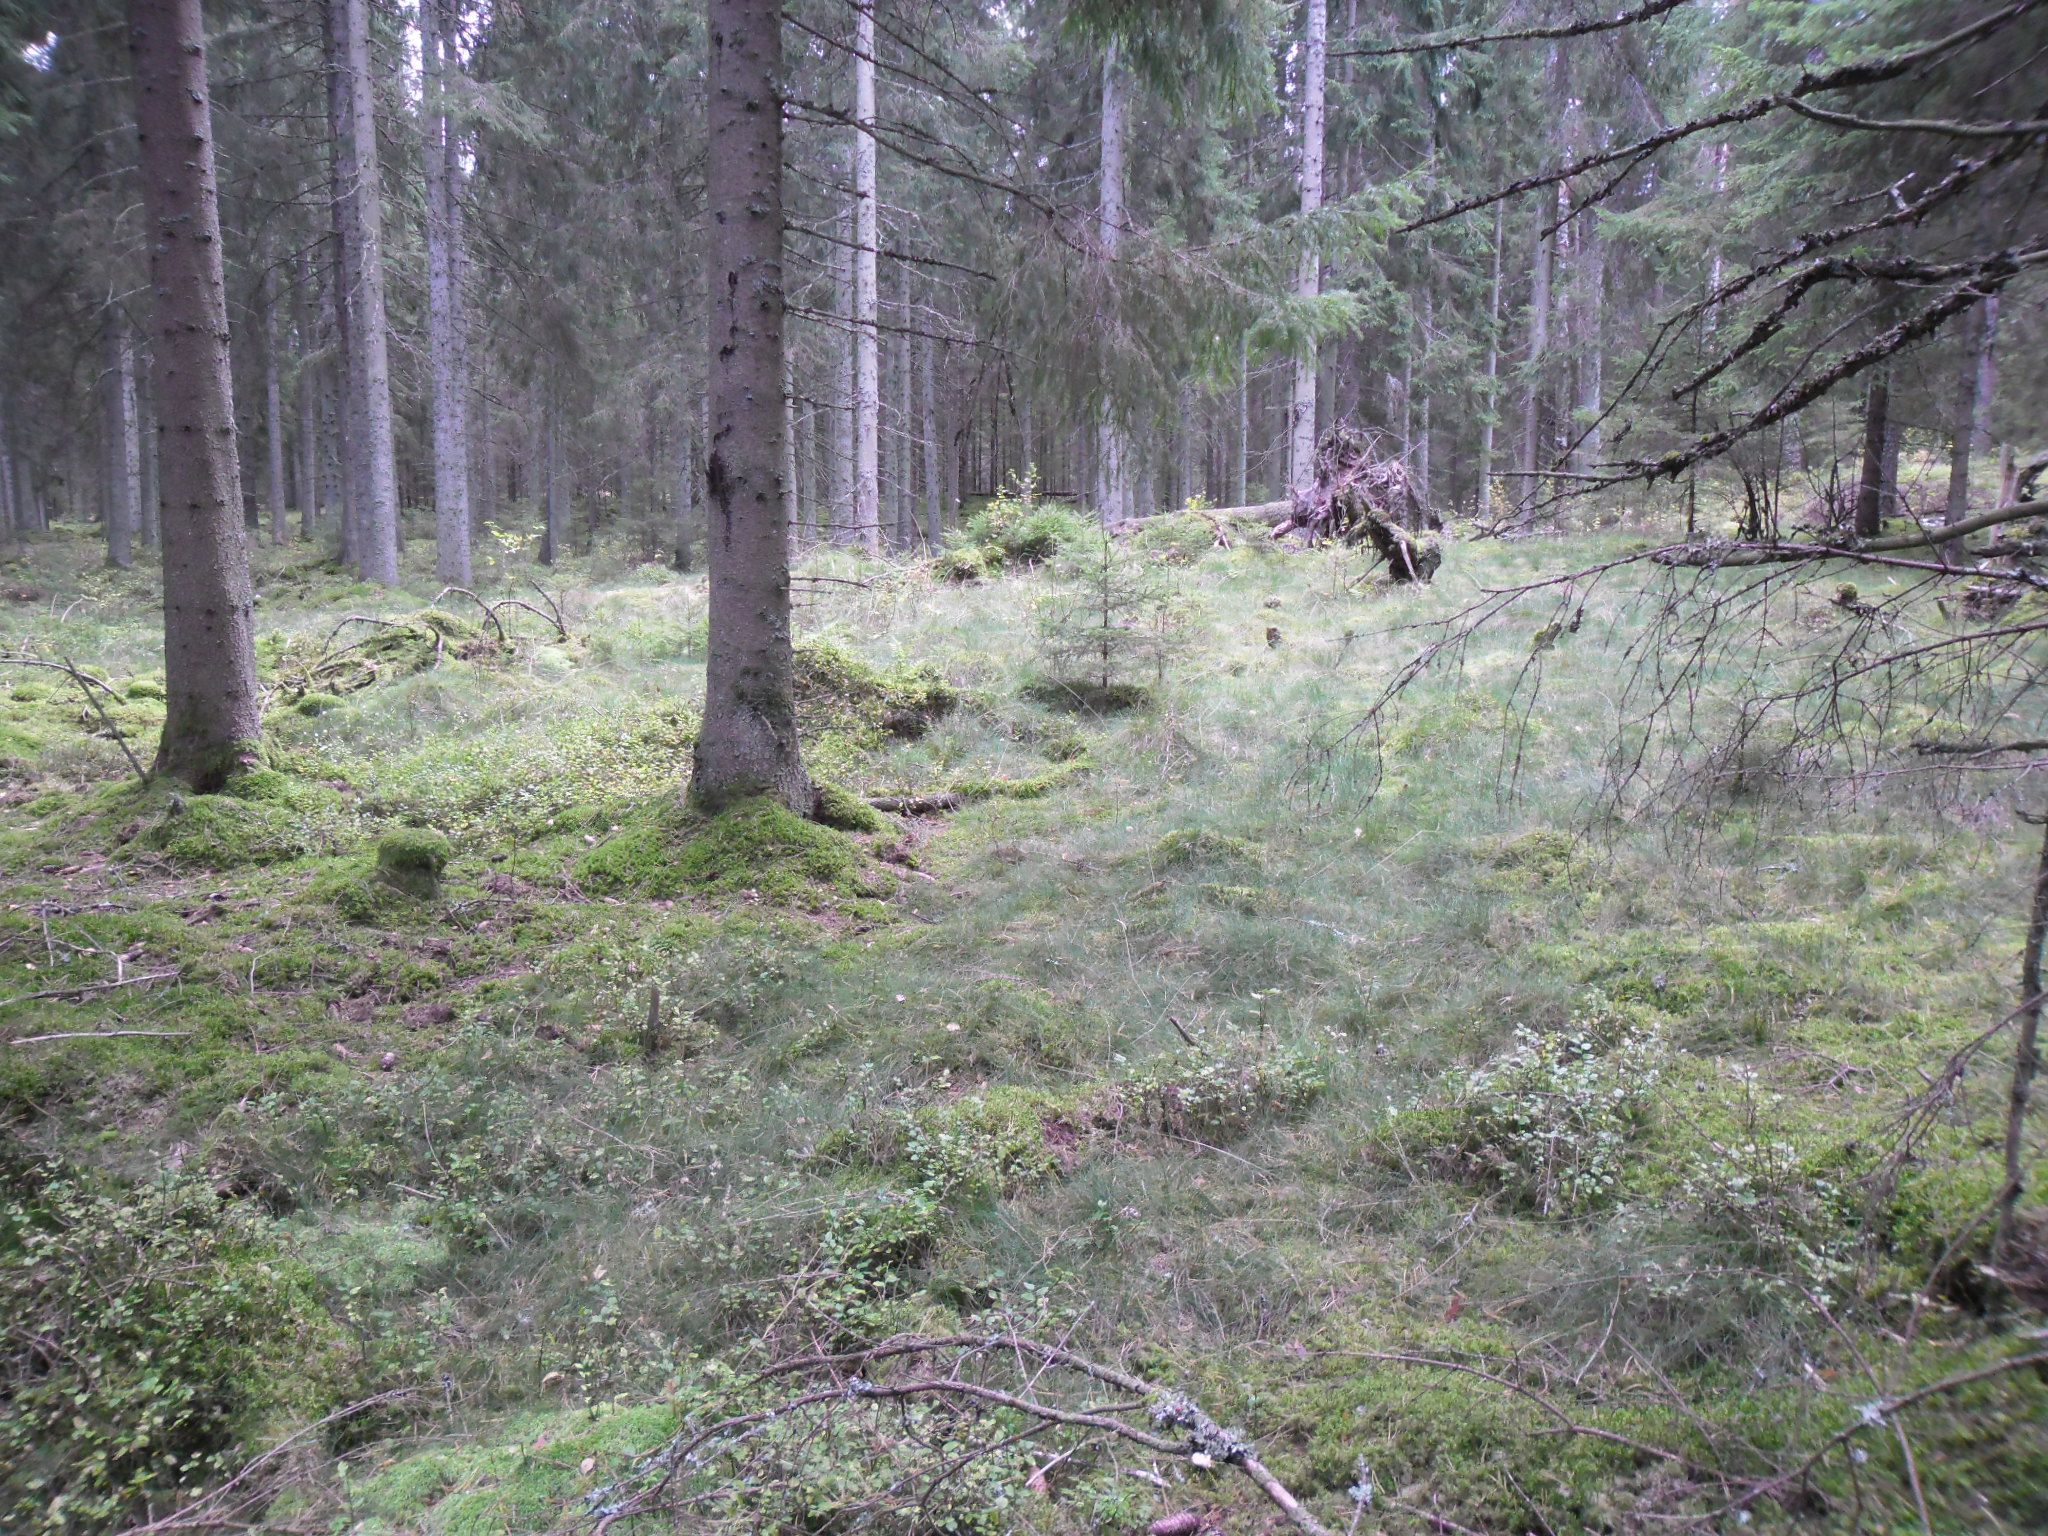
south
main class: Woodland
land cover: Spruce dominated coniferous woodland
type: boreal forest
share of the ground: > 75 %
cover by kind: coniferous forest trees 75 %, lichens and mosses 20 %, shrubs 5 %
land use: Forestry
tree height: > 5 m
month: October
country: SE
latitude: 56.4212
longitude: 13.7420
